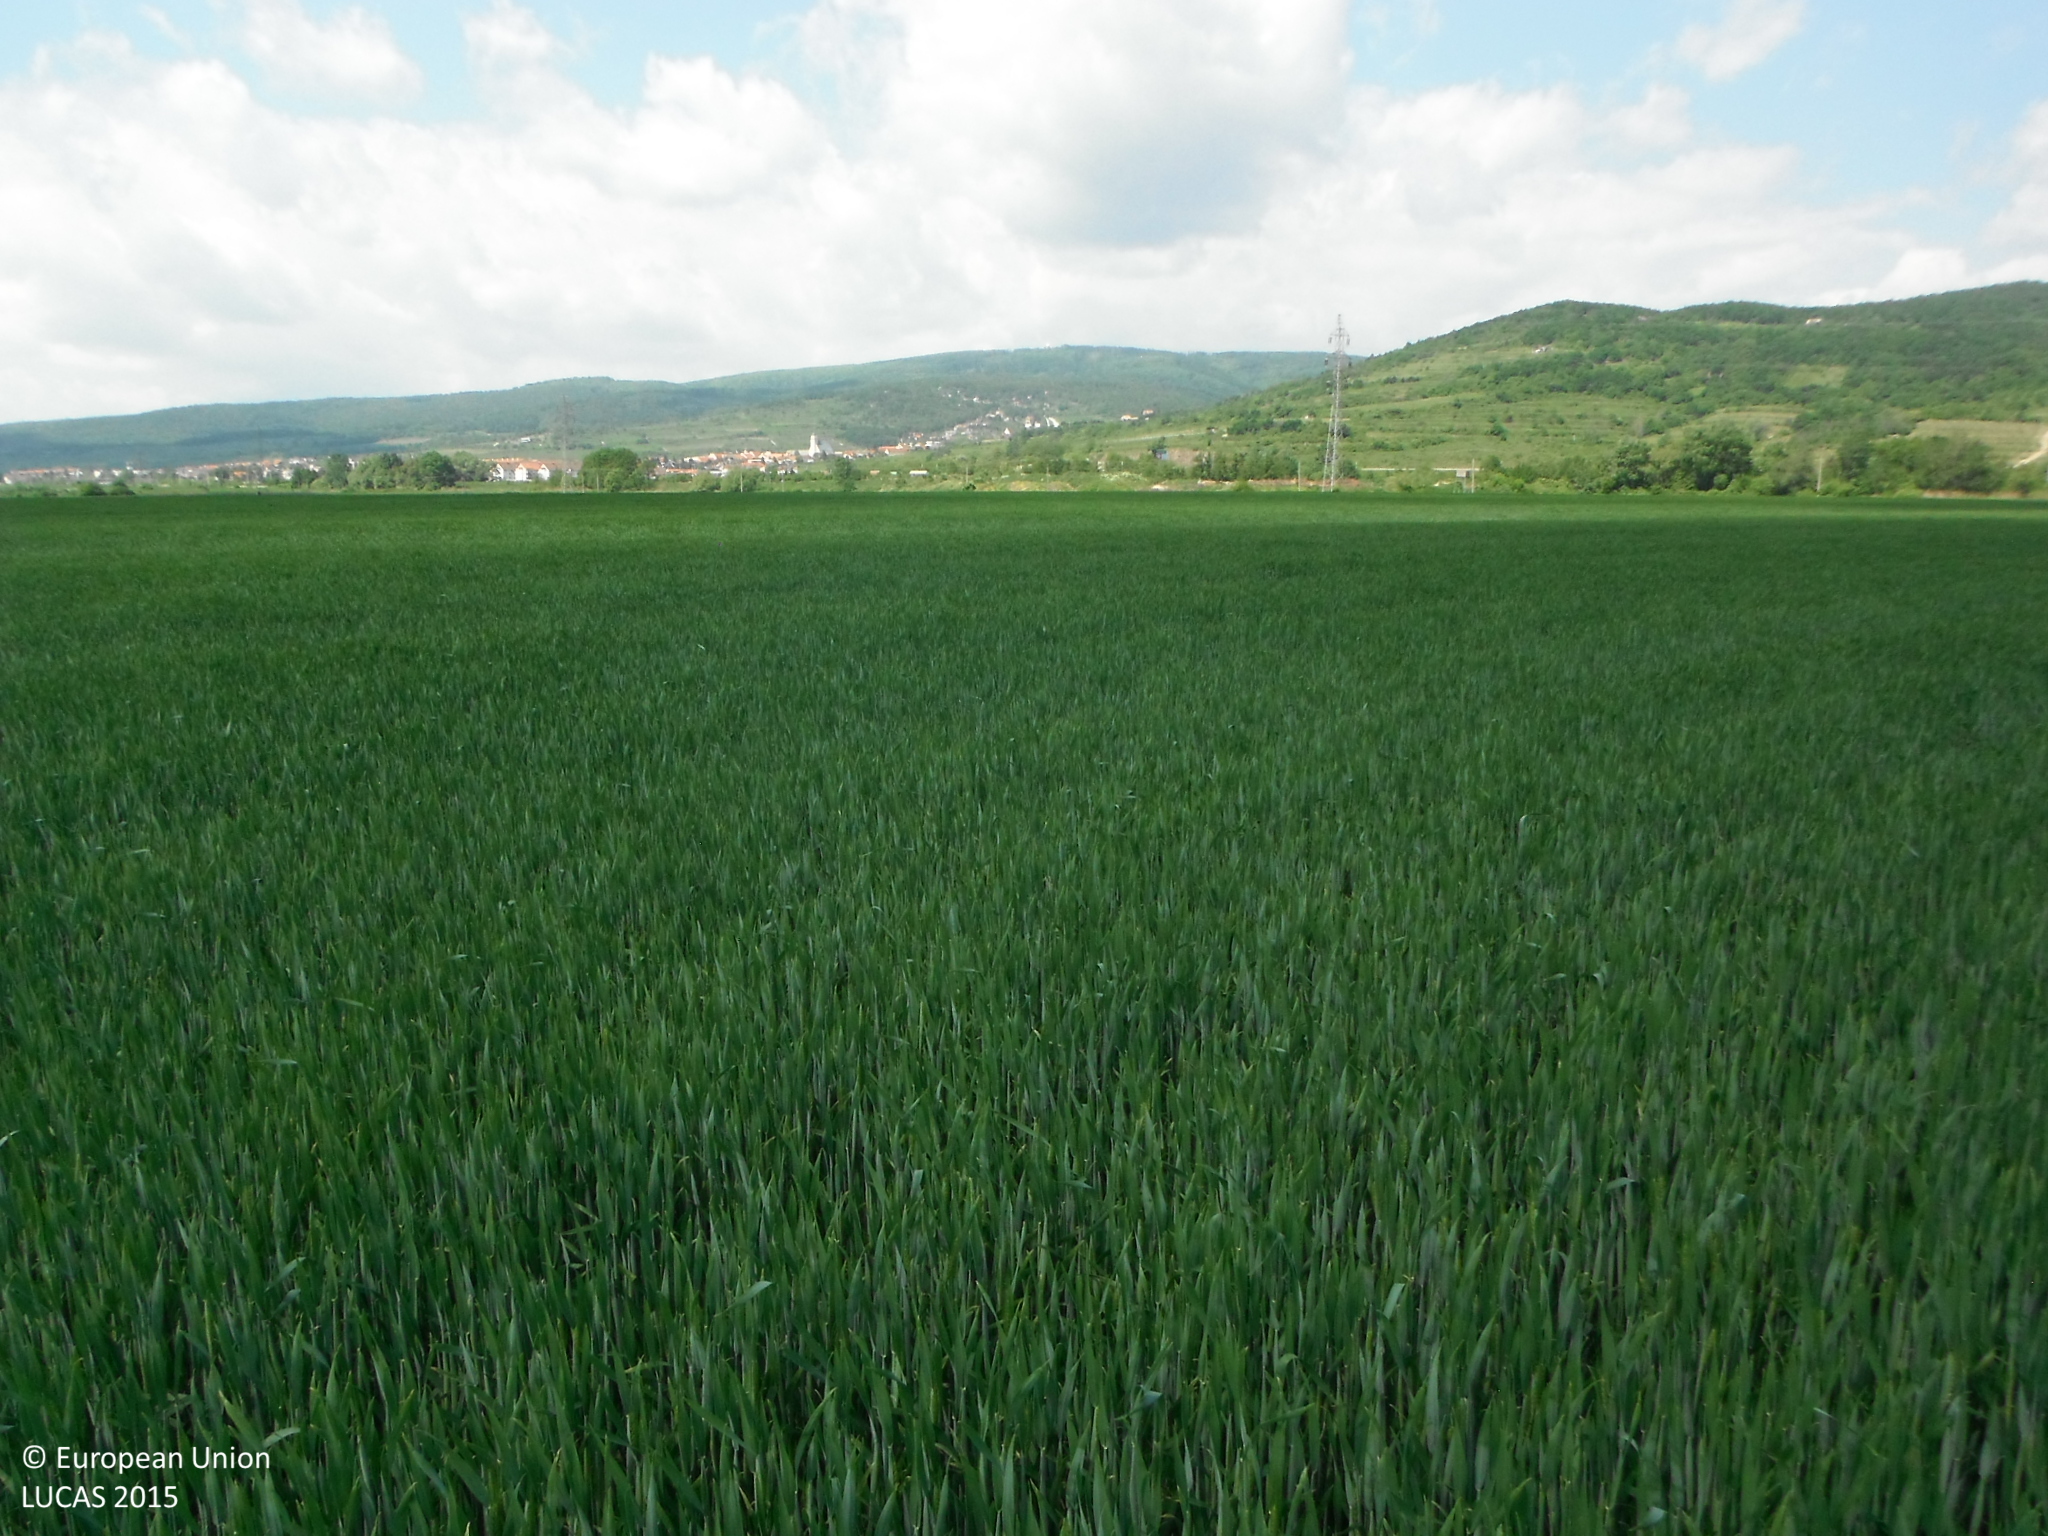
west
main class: Cropland
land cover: Common wheat
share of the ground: > 75 %
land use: Agriculture (excluding fallow land and kitchen gardens)
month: May
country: SK
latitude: 48.2562
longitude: 17.2418
